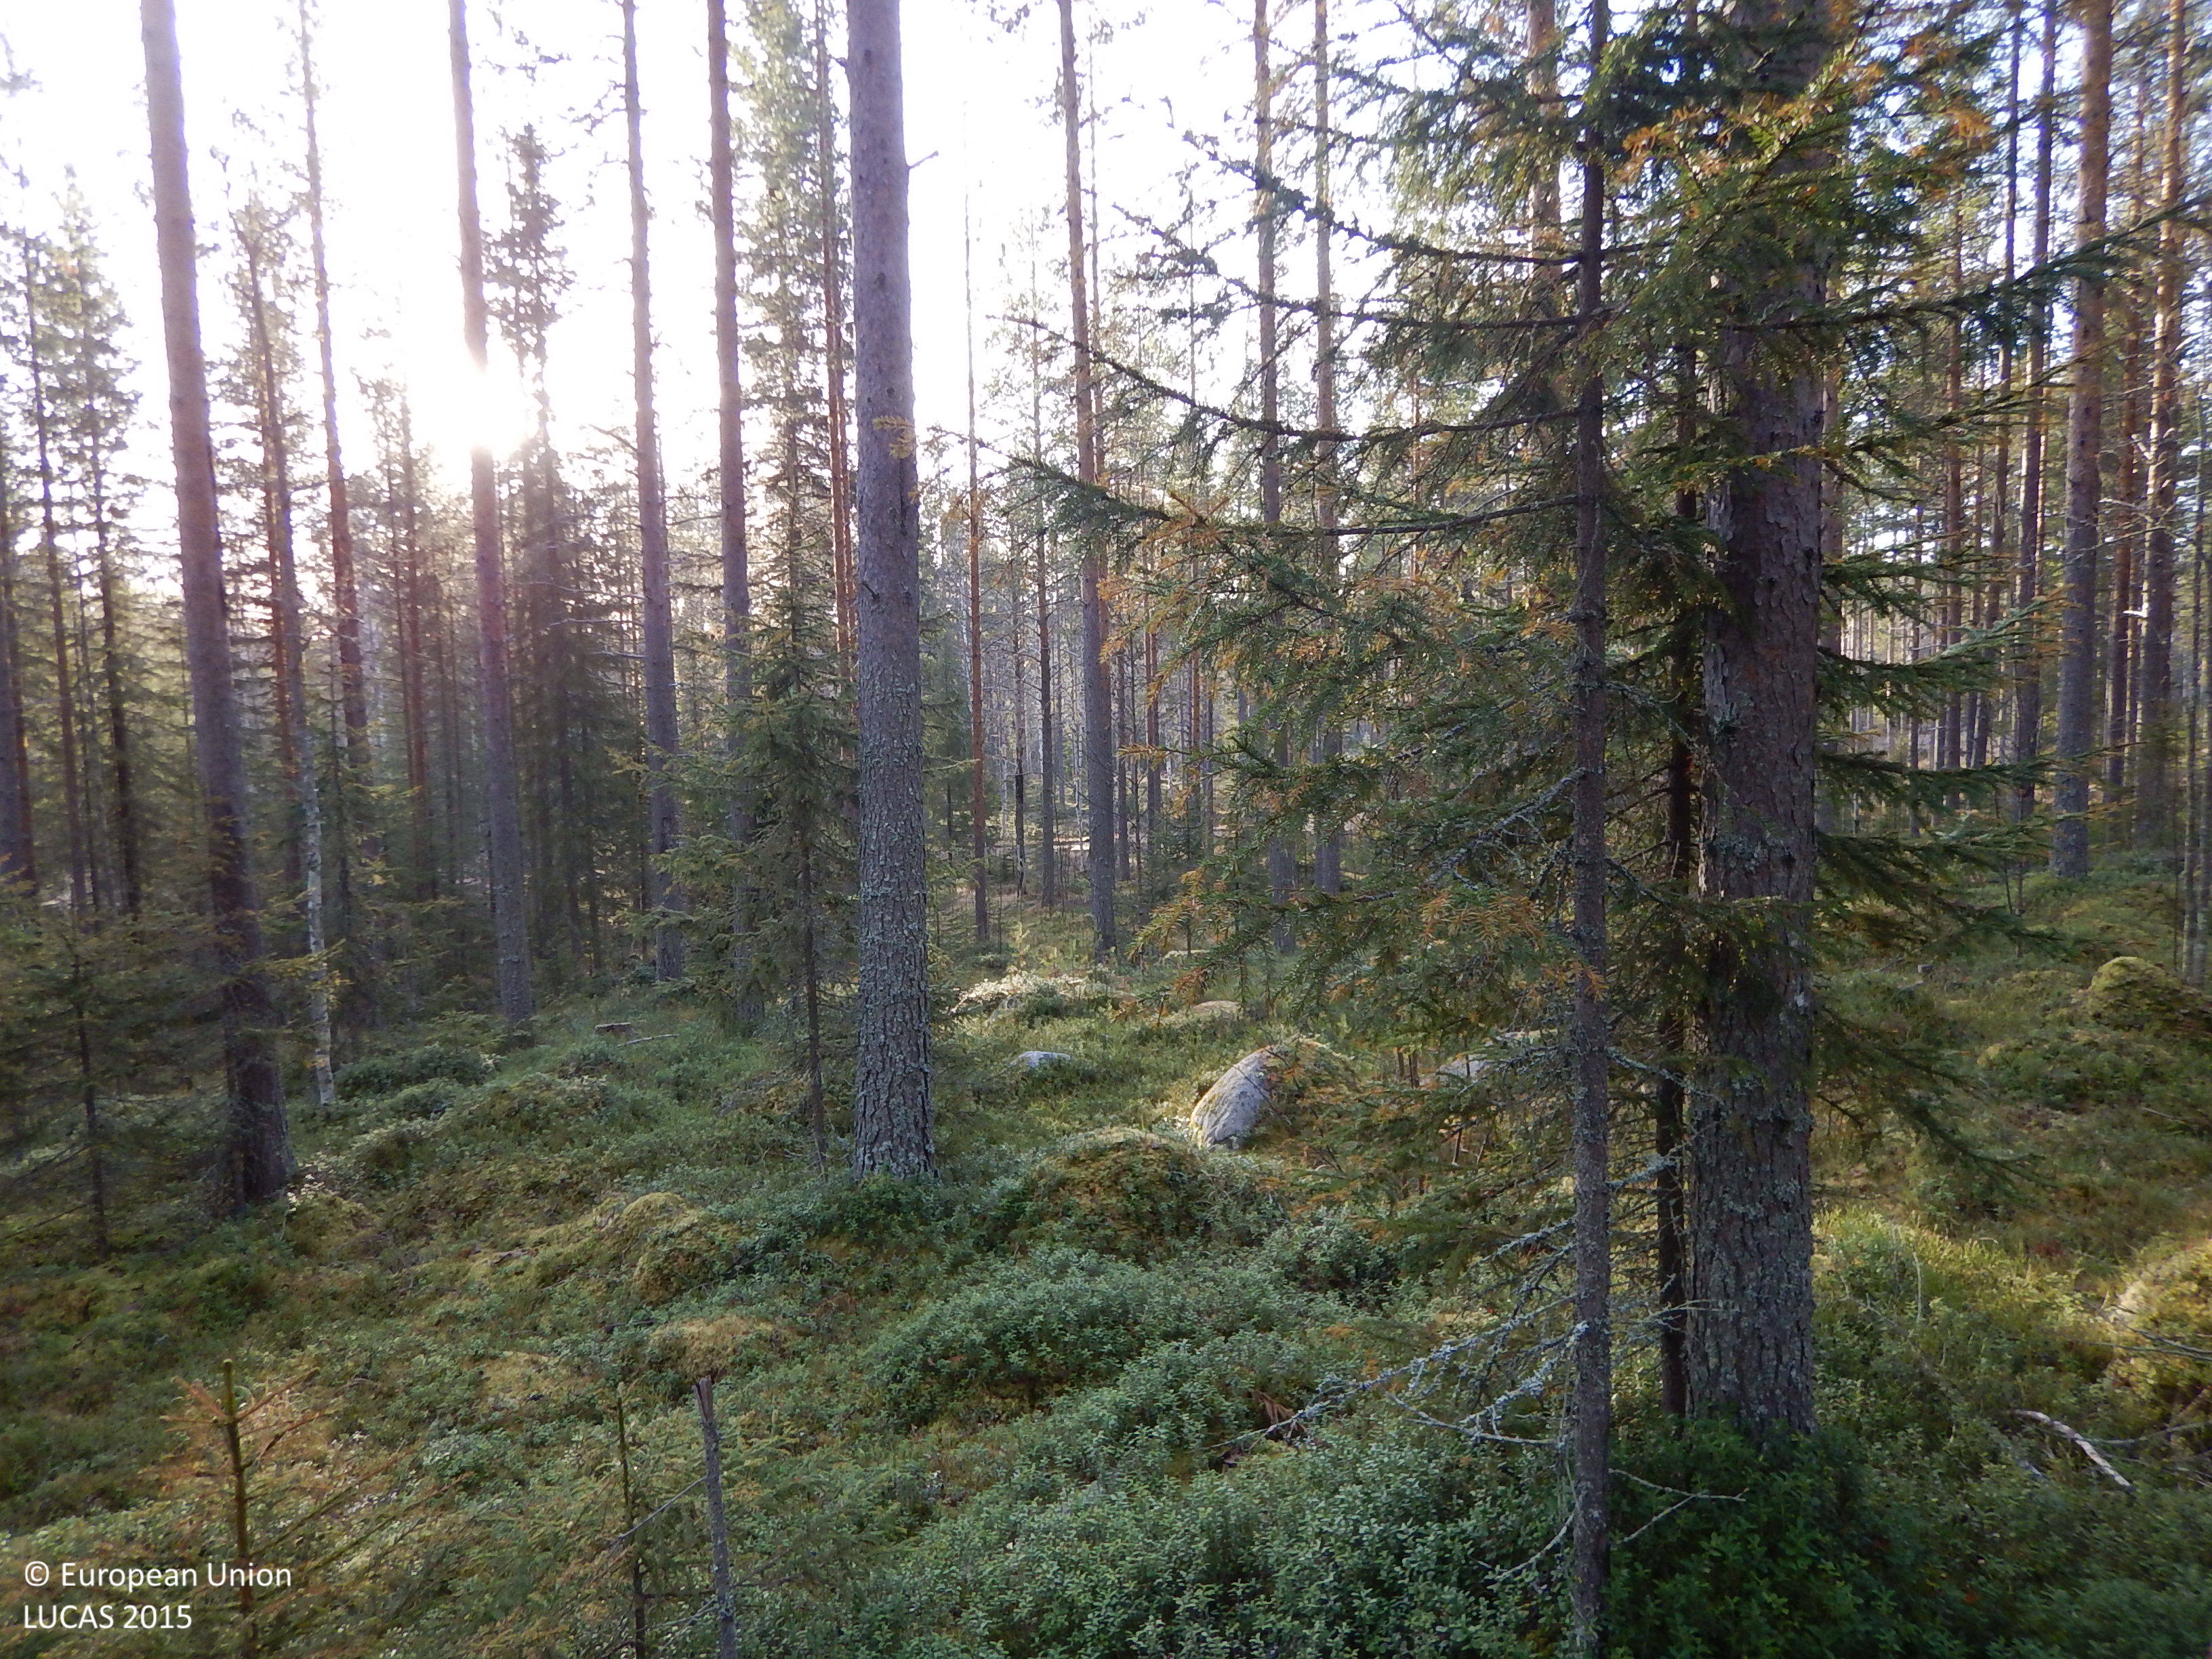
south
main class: Woodland
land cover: Other coniferous woodland
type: boreal forest
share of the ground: 50 - 75 %
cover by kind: coniferous forest trees 60 %, shrubs 15 %, lichens and mosses 15 %, broadleaved forest trees 5 %, herbaceous plants 5 %
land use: Forestry
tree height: > 5 m
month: November
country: SE
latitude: 65.1771
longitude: 20.8388
